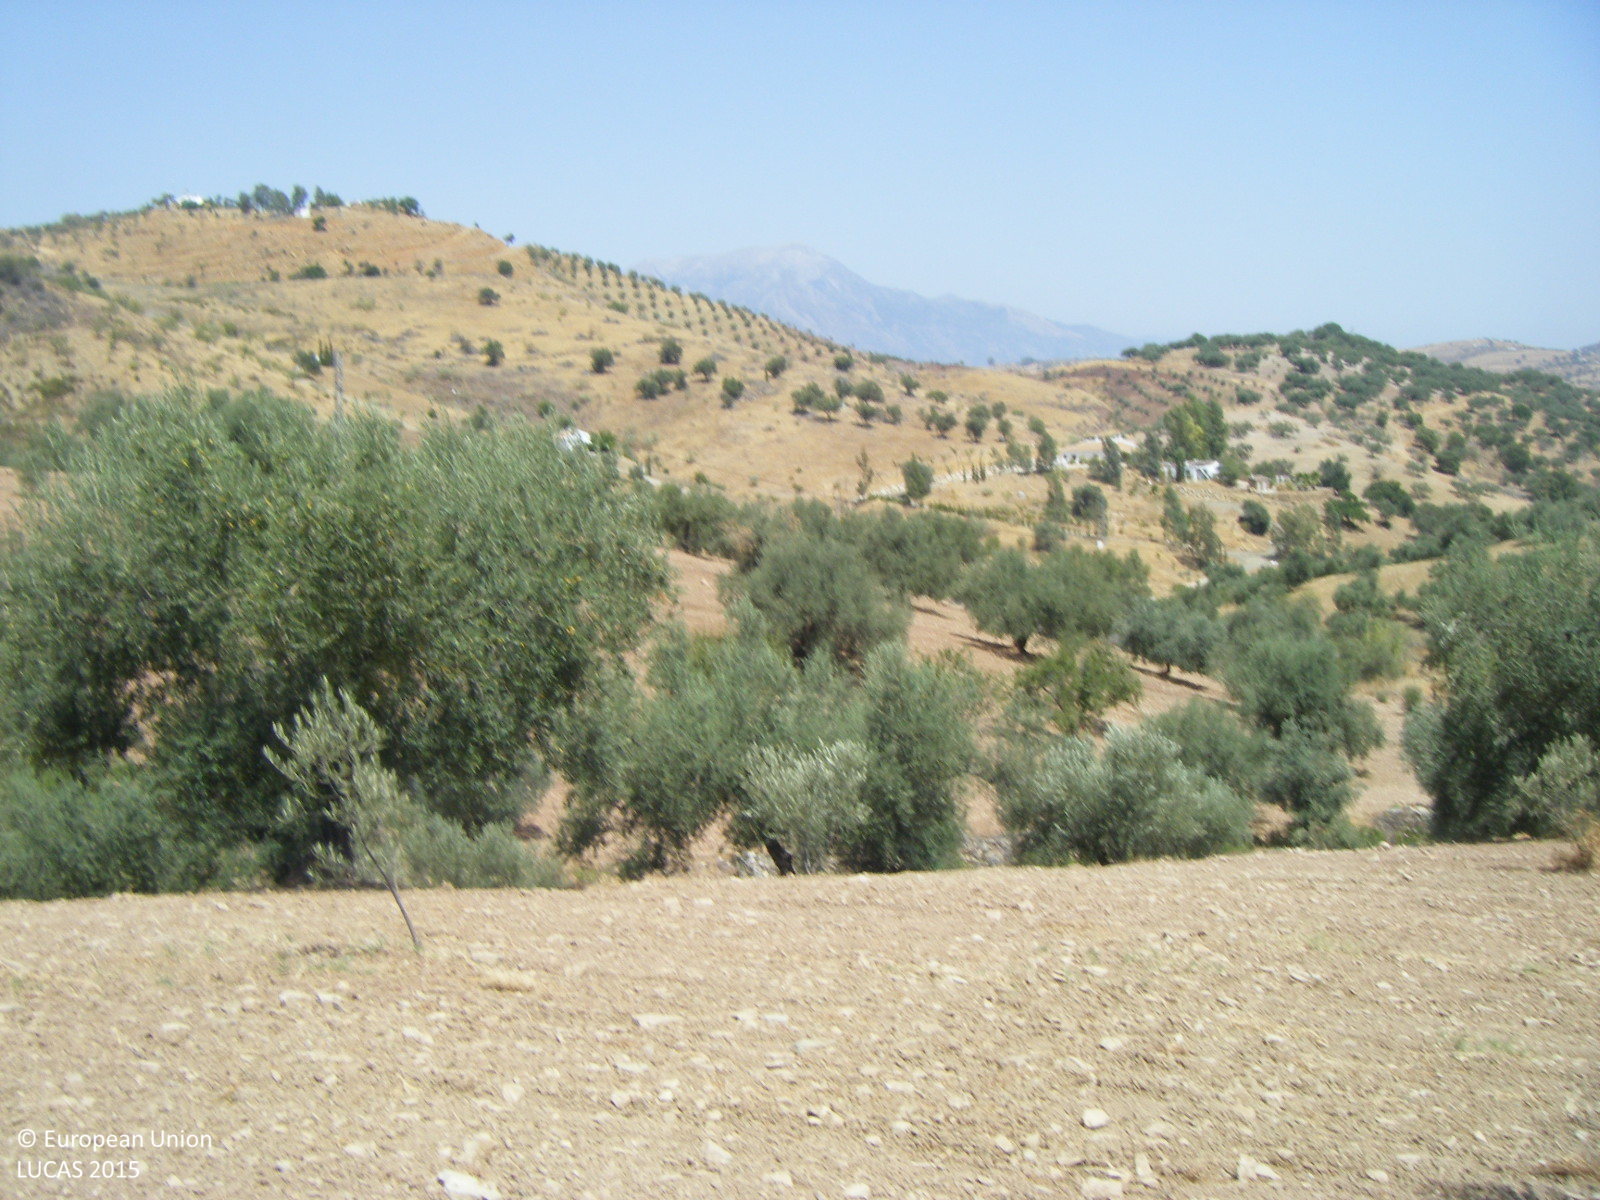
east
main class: Cropland
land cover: Olive groves
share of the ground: 10 - 25 %
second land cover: Other bare soil
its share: > 75 %
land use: Agriculture (excluding fallow land and kitchen gardens)
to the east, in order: Olive groves; Other bare soil; Rivers and streams; Olive groves; Rivers and streams; Olive groves; Tracks; Olive groves
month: July
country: ES
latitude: 36.8887
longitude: -4.2524
